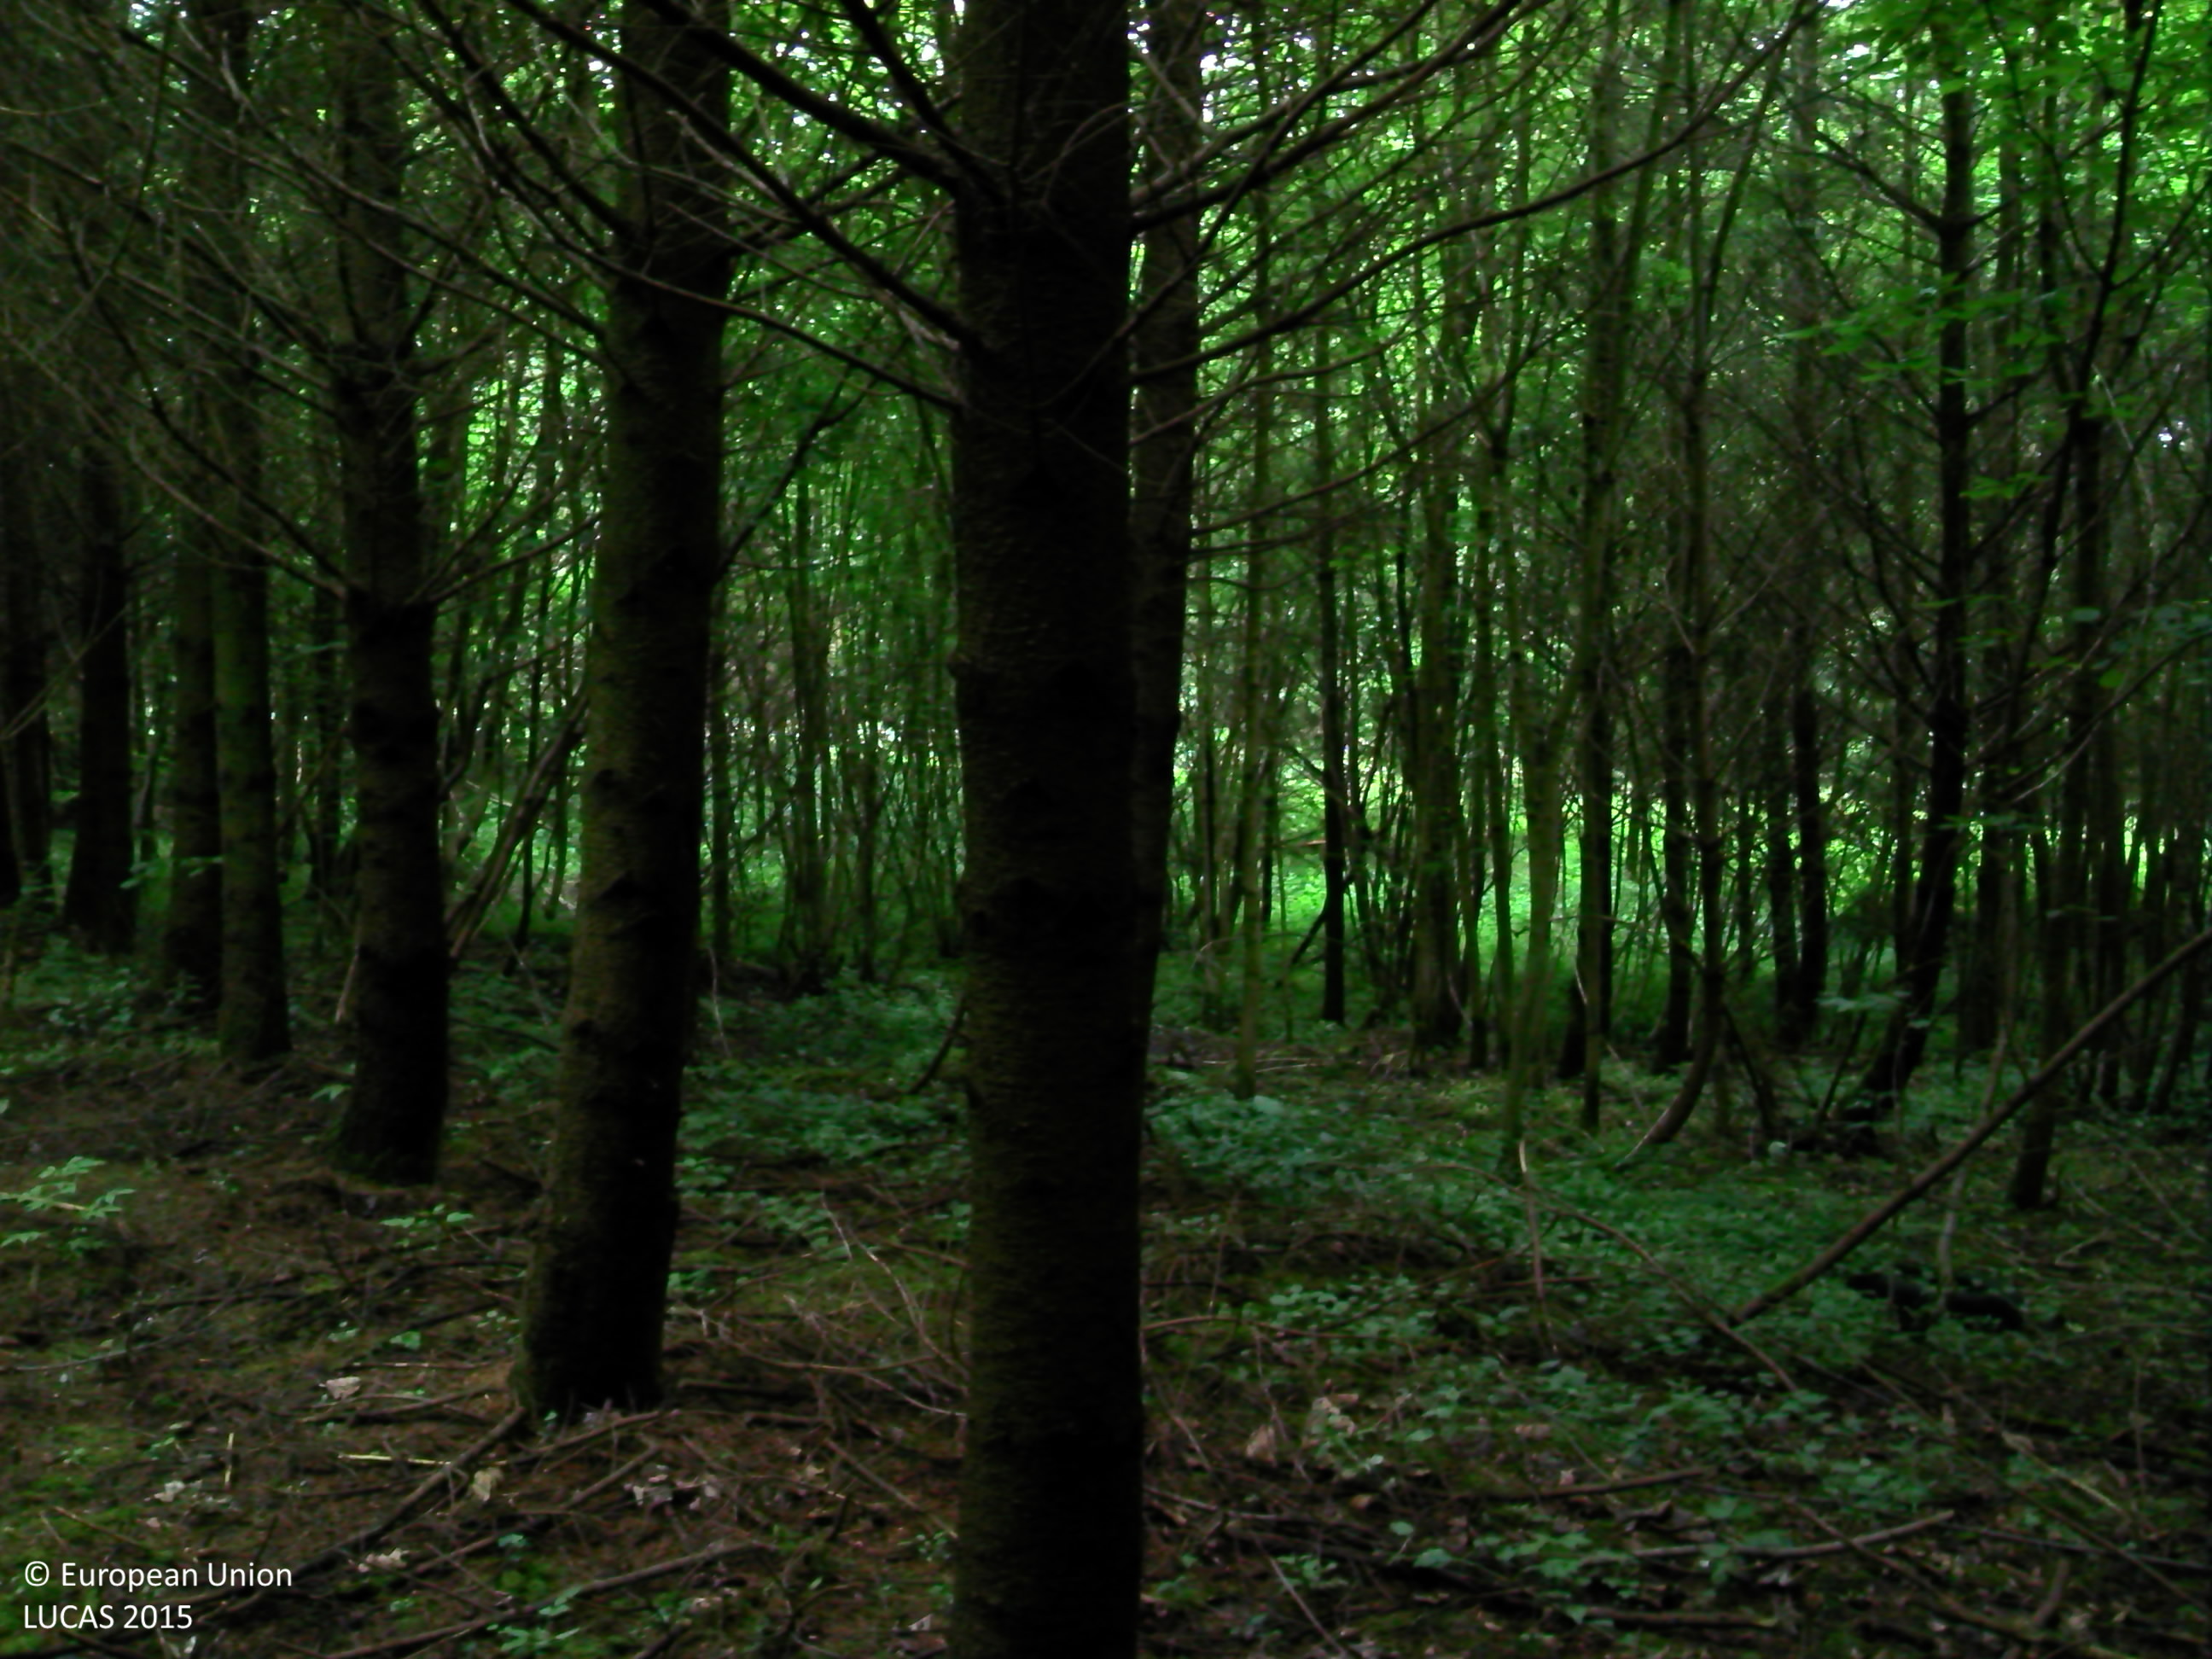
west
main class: Woodland
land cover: Spruce dominated coniferous woodland
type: exotic forest
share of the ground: > 75 %
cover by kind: coniferous forest trees 80 %, broadleaved forest trees 10 %, lichens and mosses 10 %
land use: Forestry
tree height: > 5 m
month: June
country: BE
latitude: 50.4906
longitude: 5.4735
